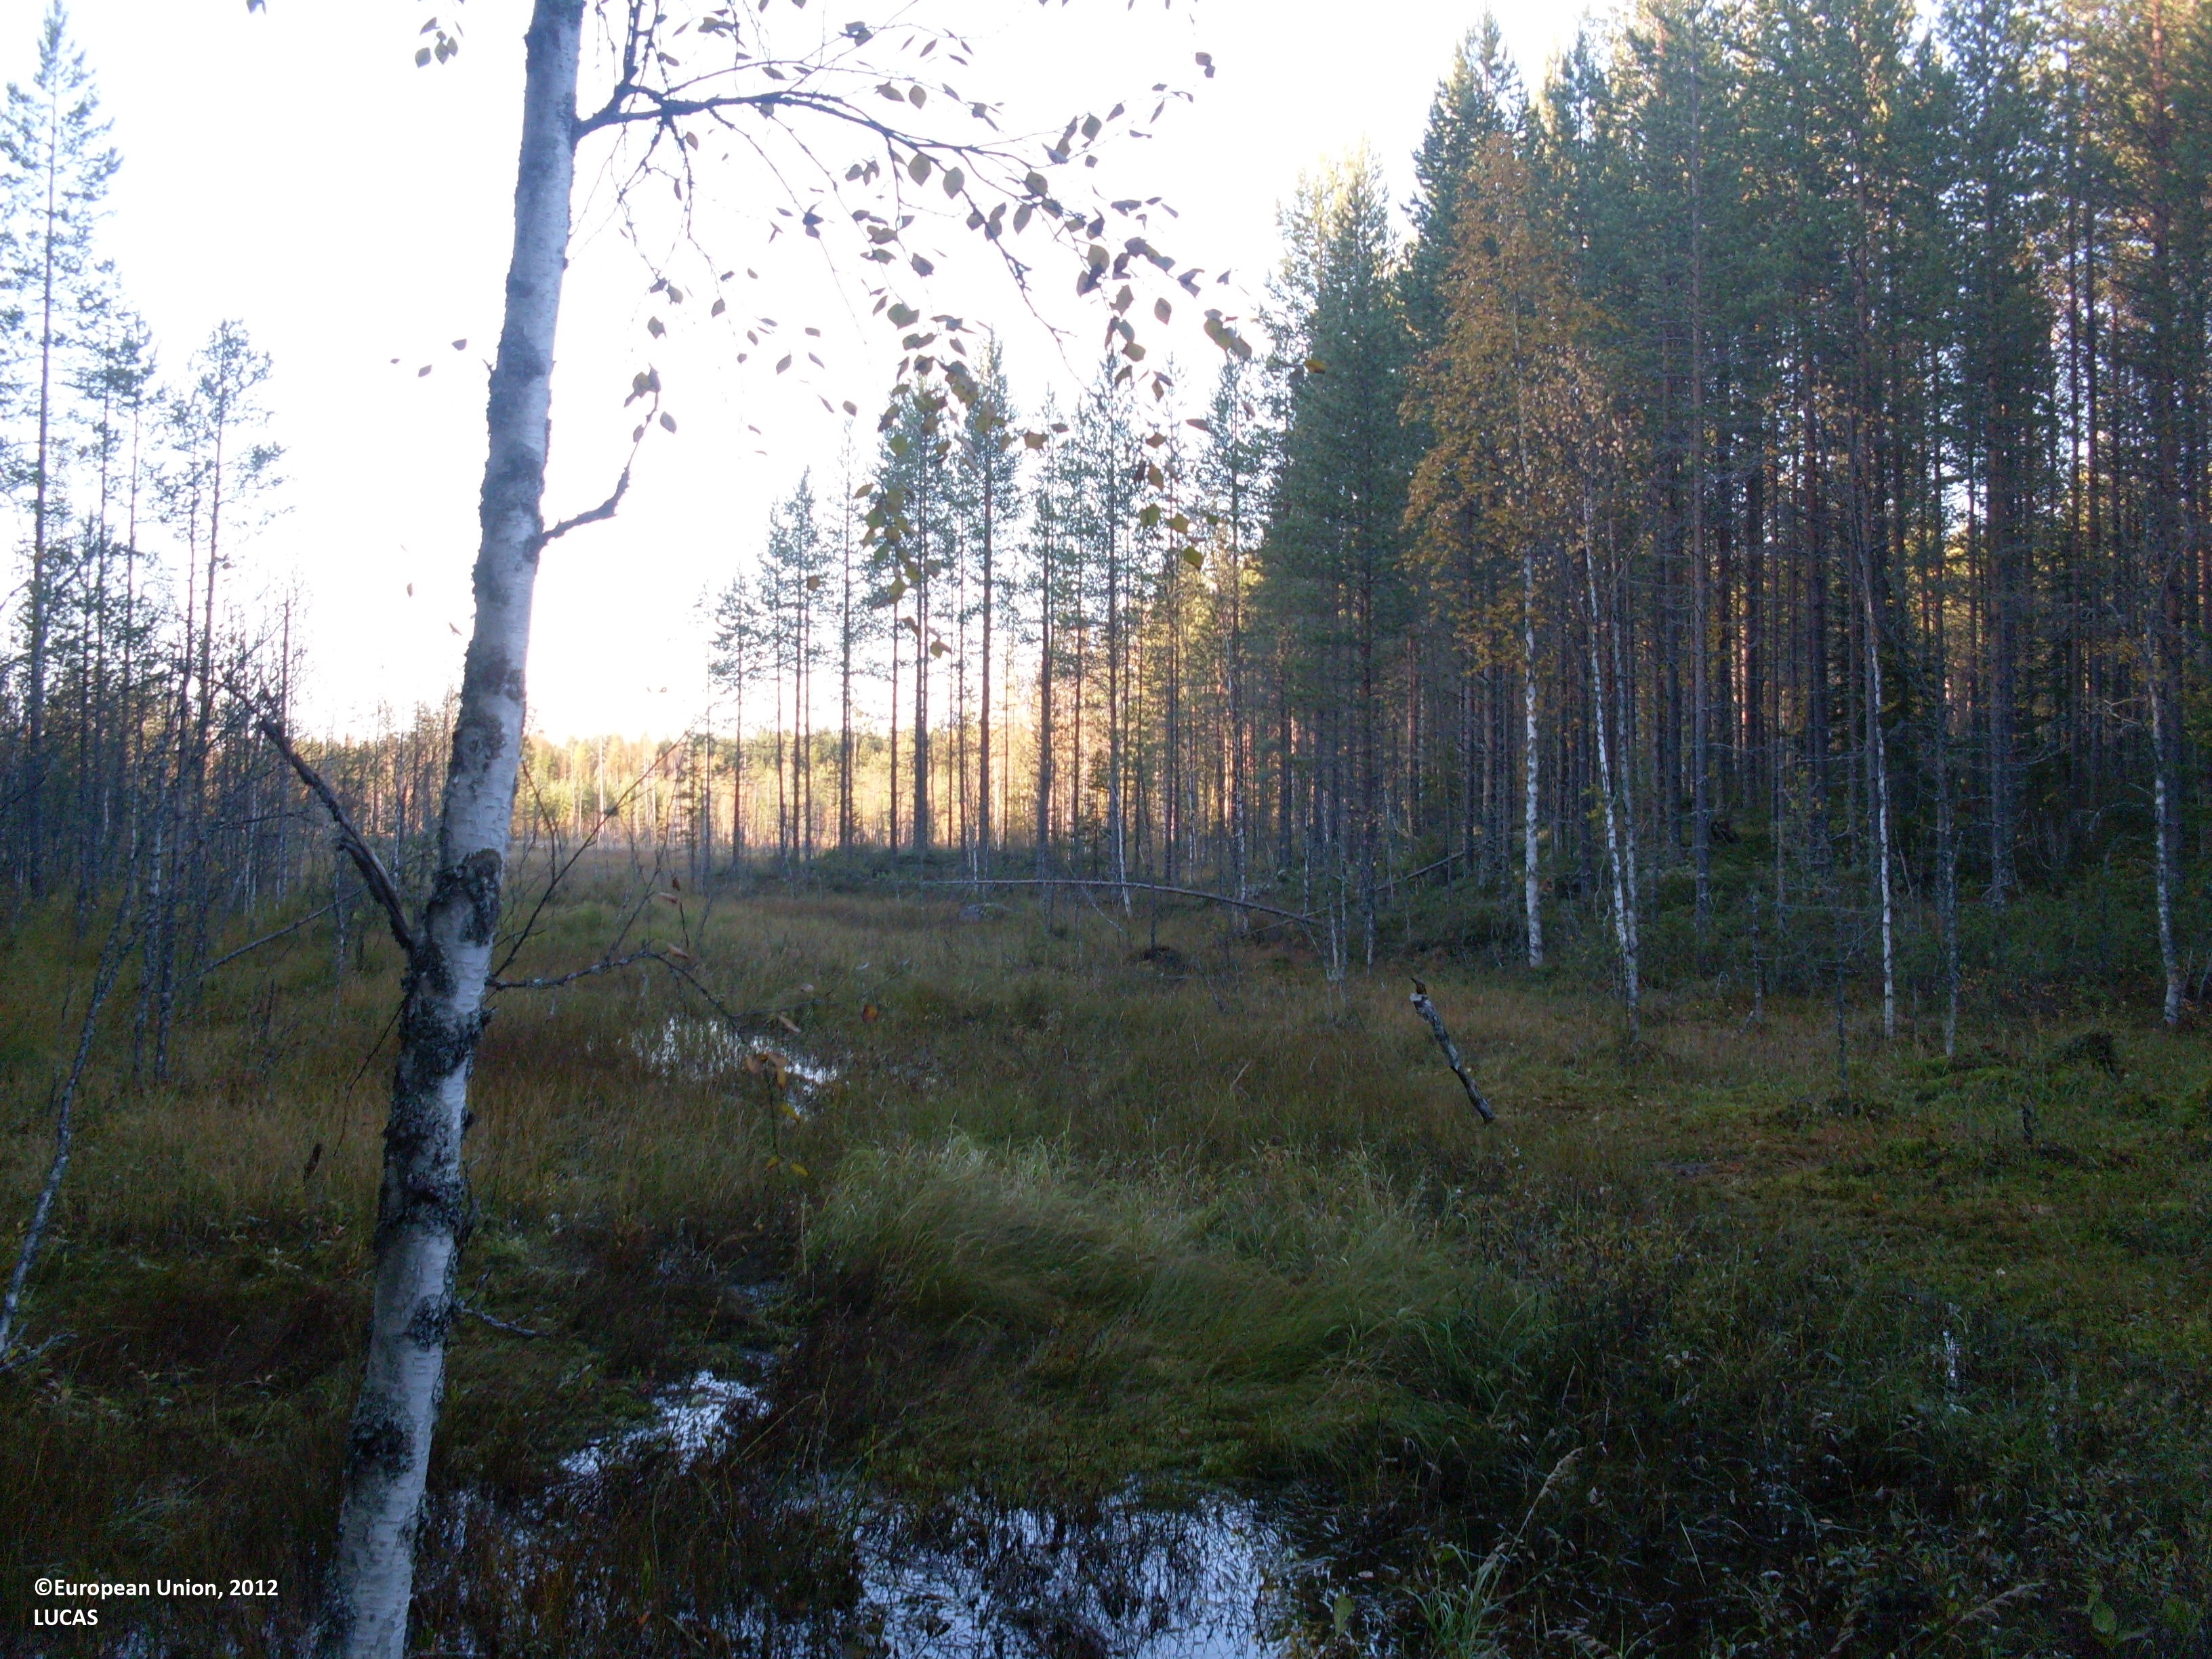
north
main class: Woodland
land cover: Pine dominated mixed woodland
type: boreal forest
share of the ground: > 75 %
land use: Forestry
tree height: > 5 m
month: September
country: FI
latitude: 64.2130
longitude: 28.6238
